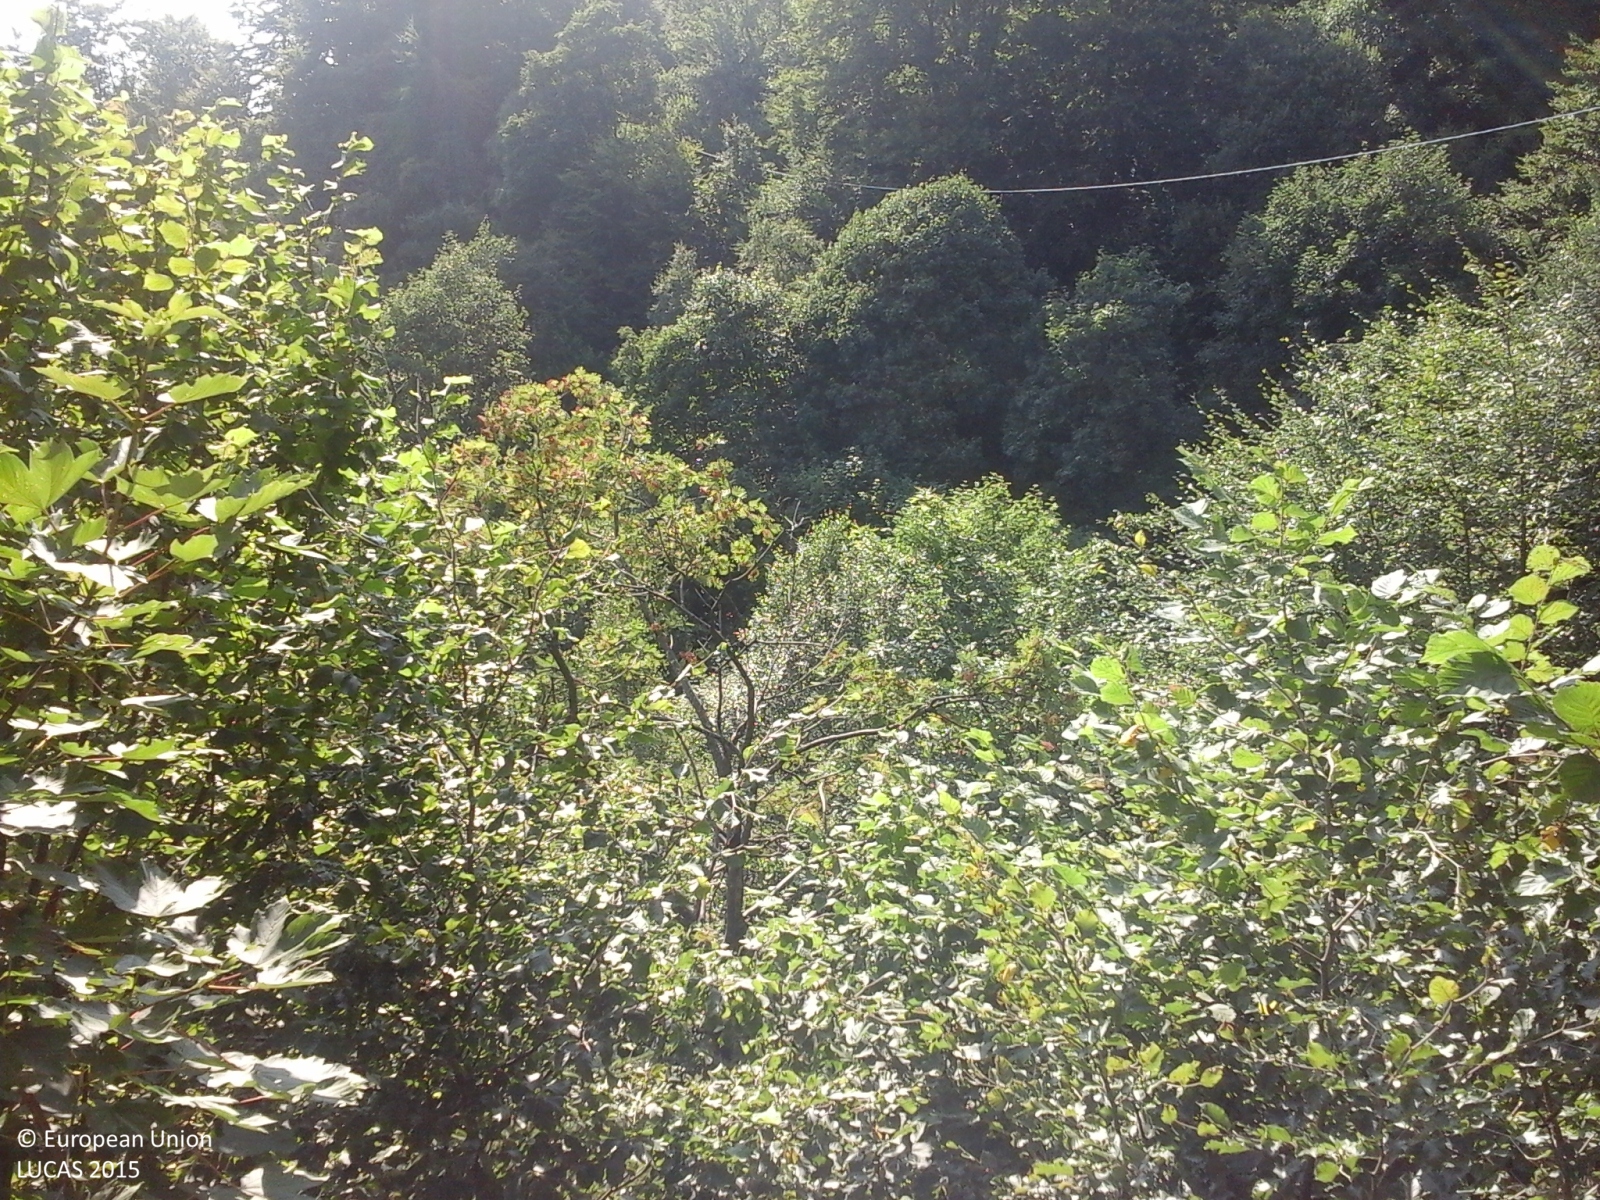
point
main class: Woodland
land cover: Broadleaved woodland
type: mesophytic deciduous forest
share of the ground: > 75 %
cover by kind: broadleaved forest trees 100 %
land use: Semi-natural and natural areas not in use
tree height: > 5 m
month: July
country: IT
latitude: 44.8723
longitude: 7.2076
